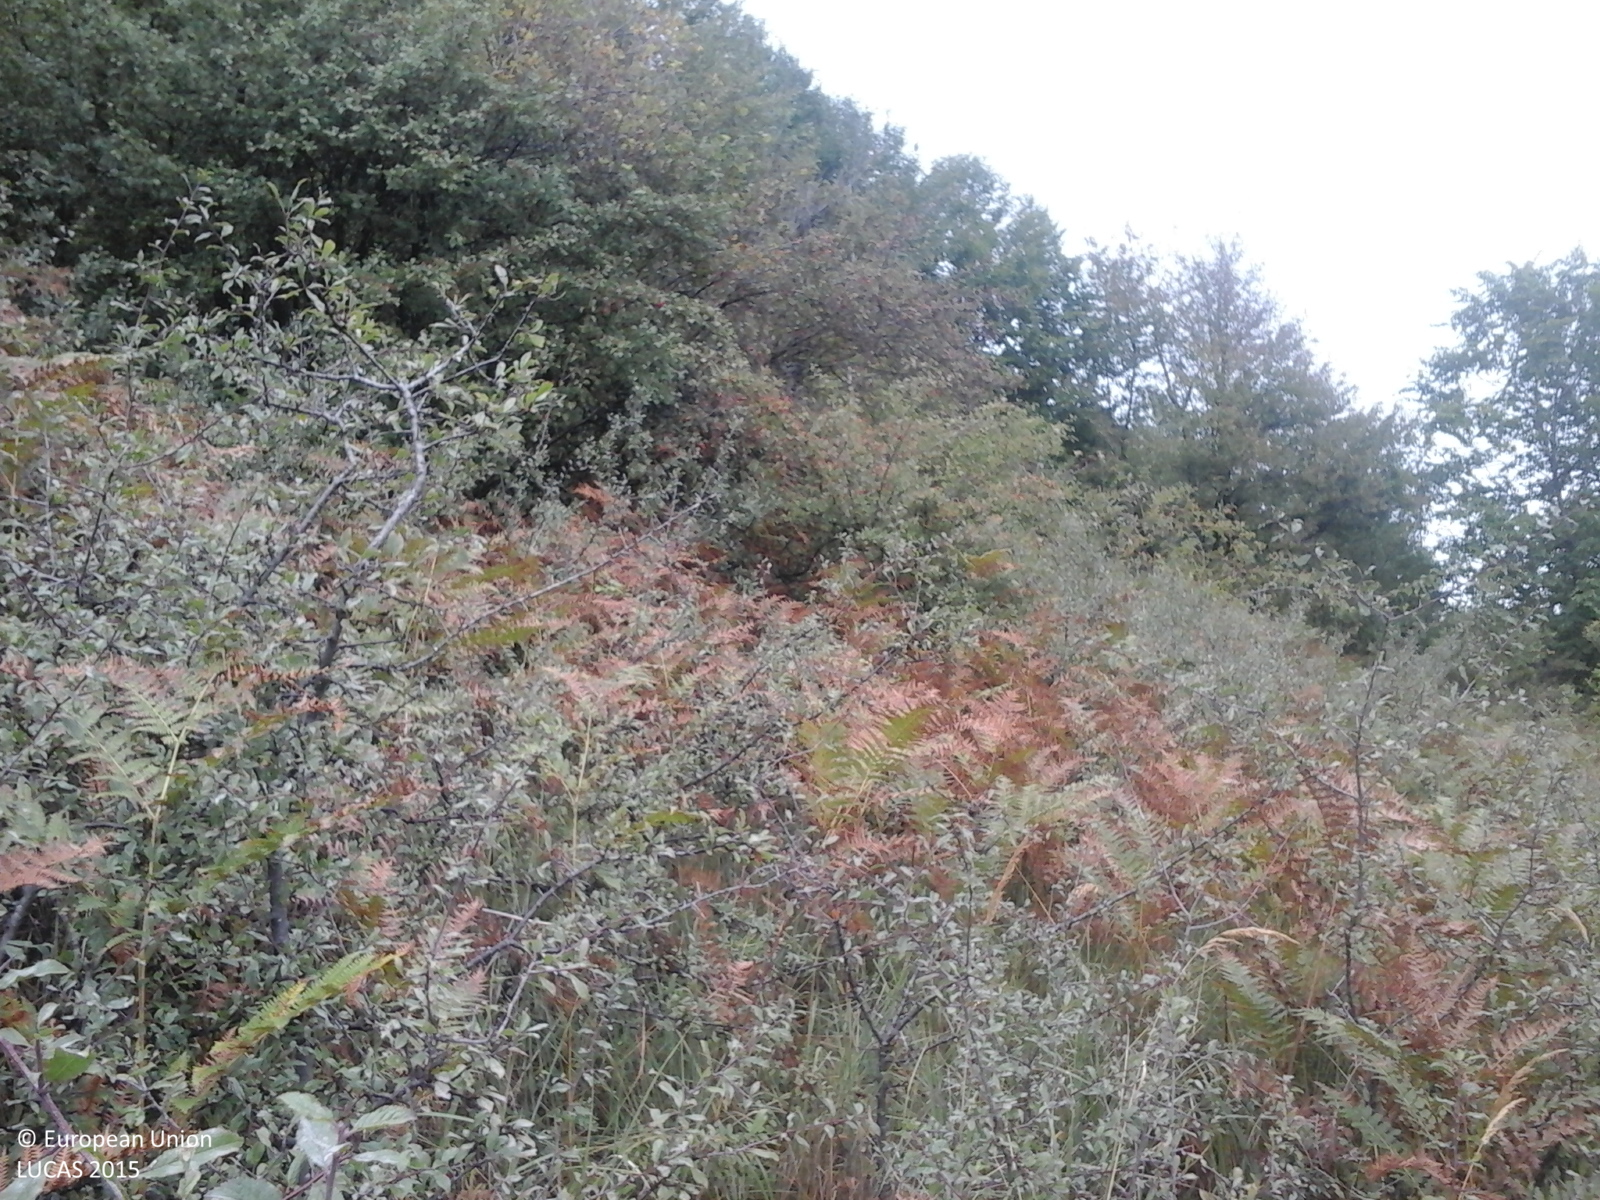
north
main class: Shrubland
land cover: Shrubland with sparse tree cover
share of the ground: > 75 %
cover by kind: shrubs 95 %, broadleaved forest trees 5 %
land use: Fallow land
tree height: < 5 m
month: September
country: RO
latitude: 46.8826
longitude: 22.5603
